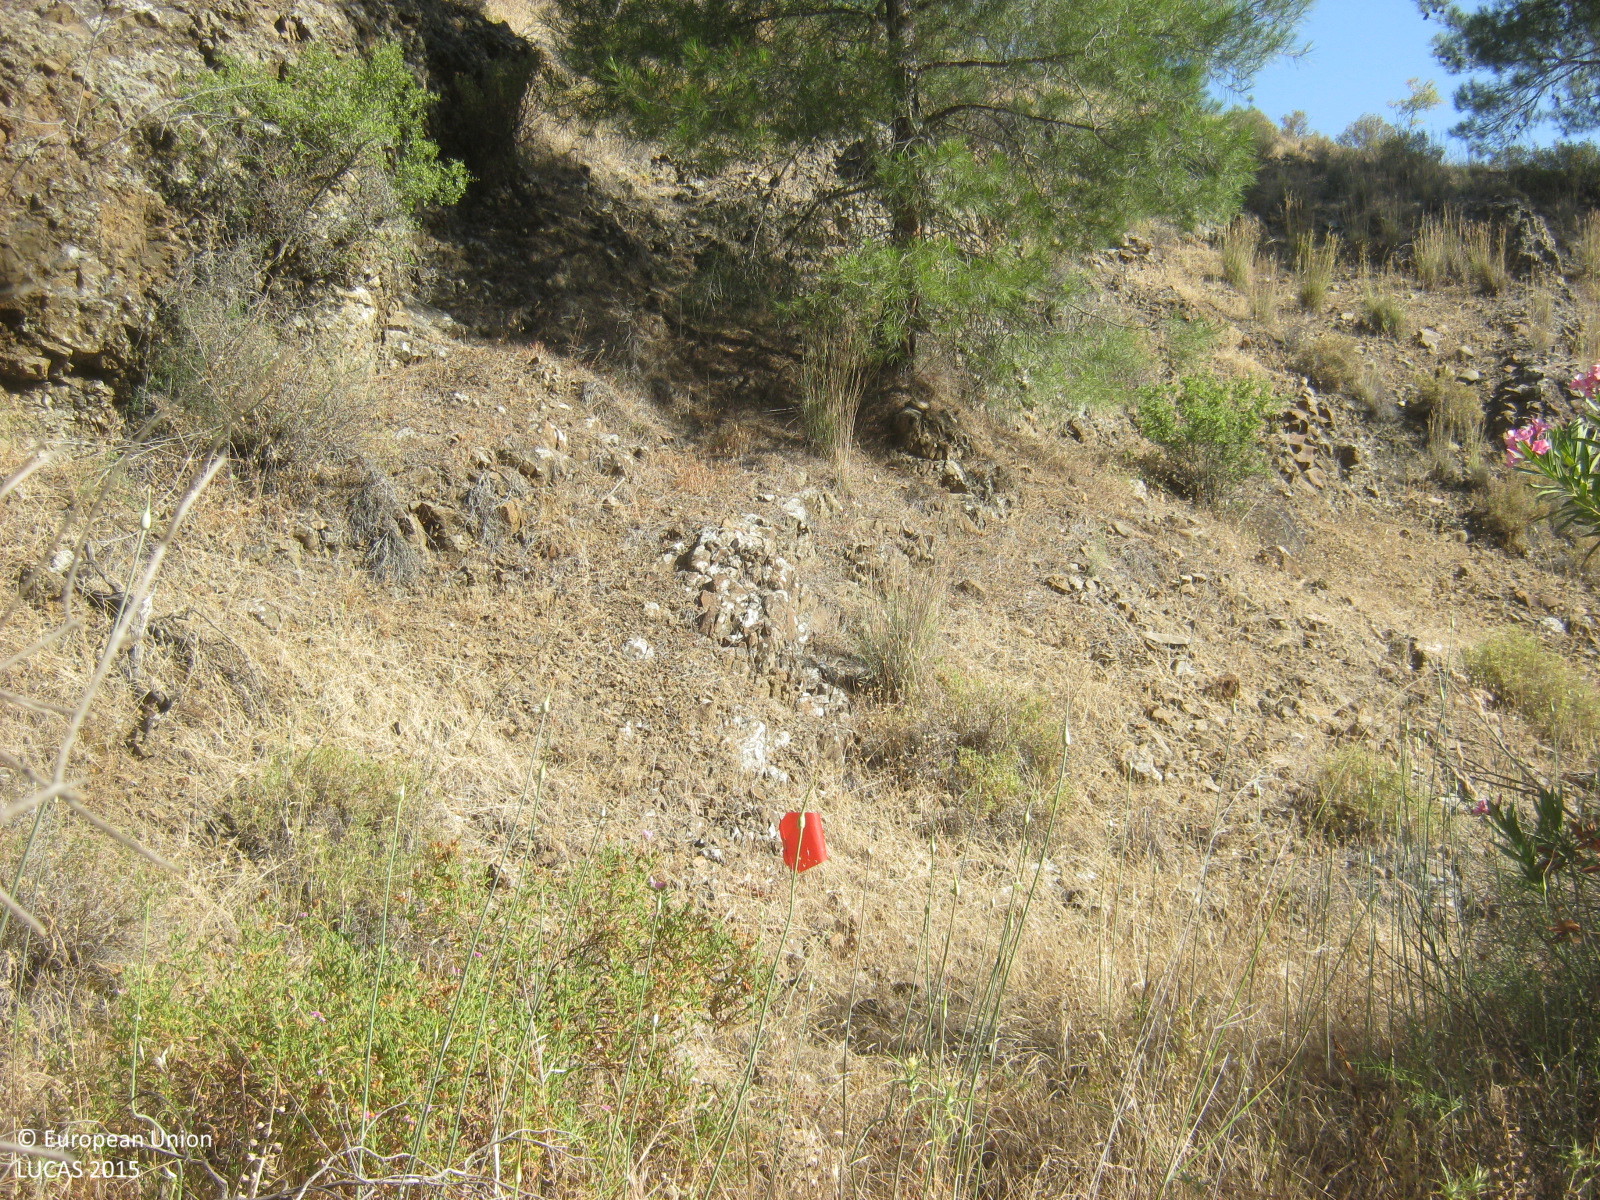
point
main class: Shrubland
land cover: Shrubland with sparse tree cover
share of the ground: 25 - 50 %
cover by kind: shrubs 30 %, herbaceous plants 30 %, consolidated bare surface 20 %, unconsolidated bare surface 15 %, coniferous forest trees 5 %
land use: Semi-natural and natural areas not in use
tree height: > 5 m
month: June
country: CY
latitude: 35.0368
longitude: 33.0770
